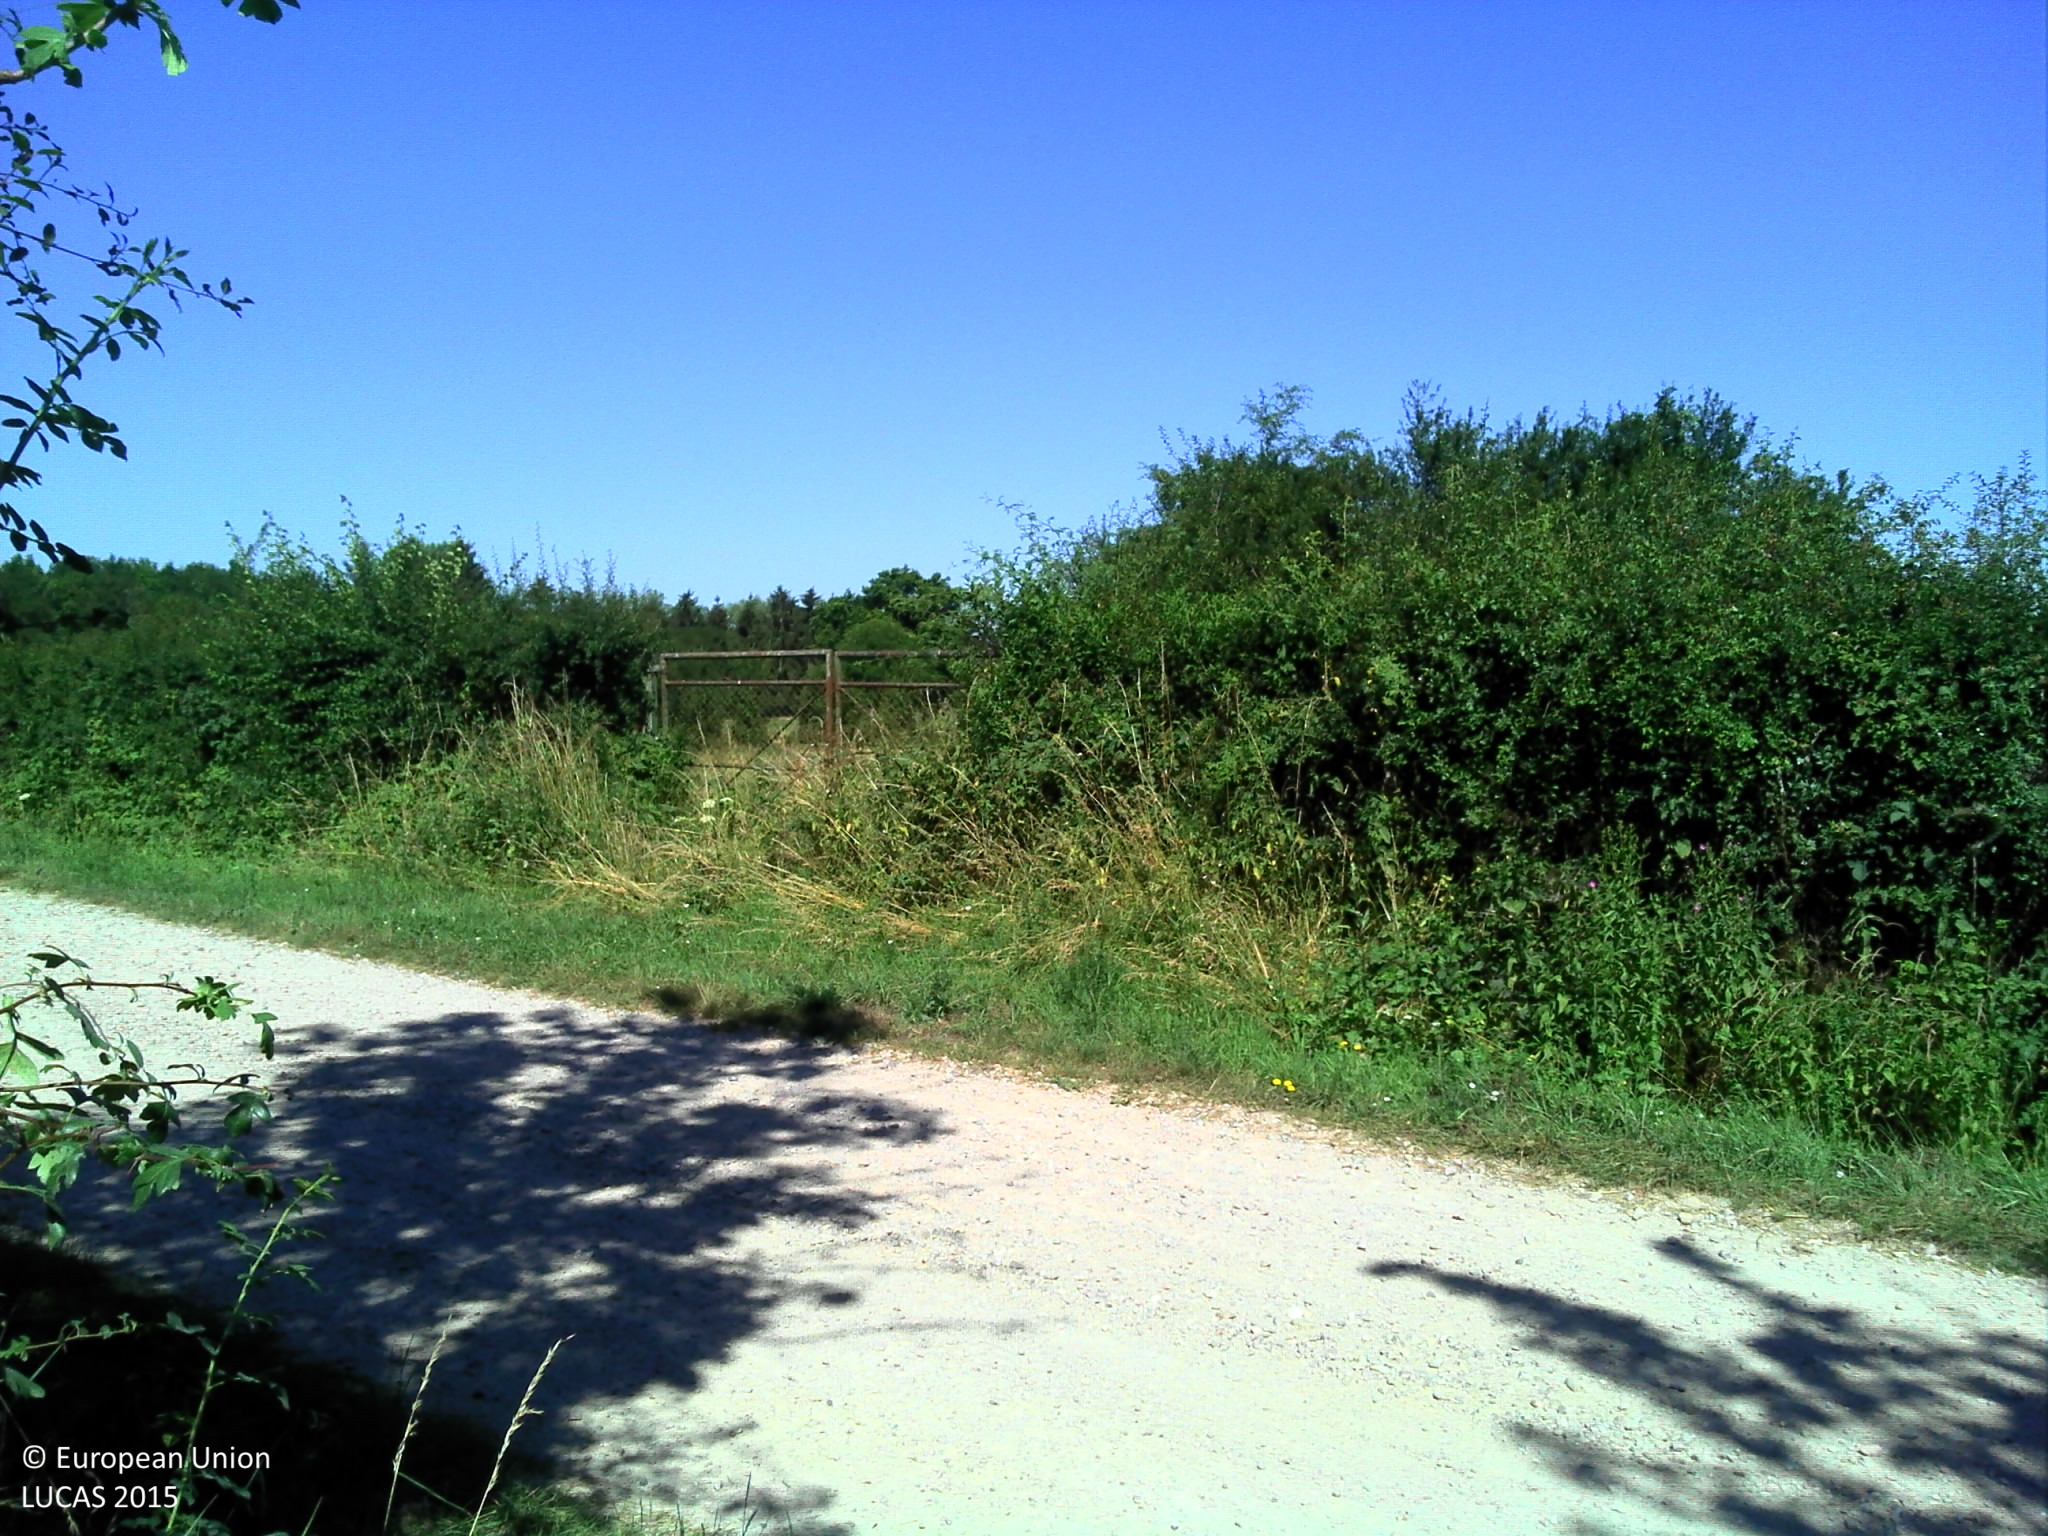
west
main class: Grassland
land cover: Grassland without tree/shrub cover
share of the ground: > 75 %
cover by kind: herbaceous plants 100 %
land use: Agriculture (excluding fallow land and kitchen gardens)
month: June
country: FR
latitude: 46.1936
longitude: 3.2740
